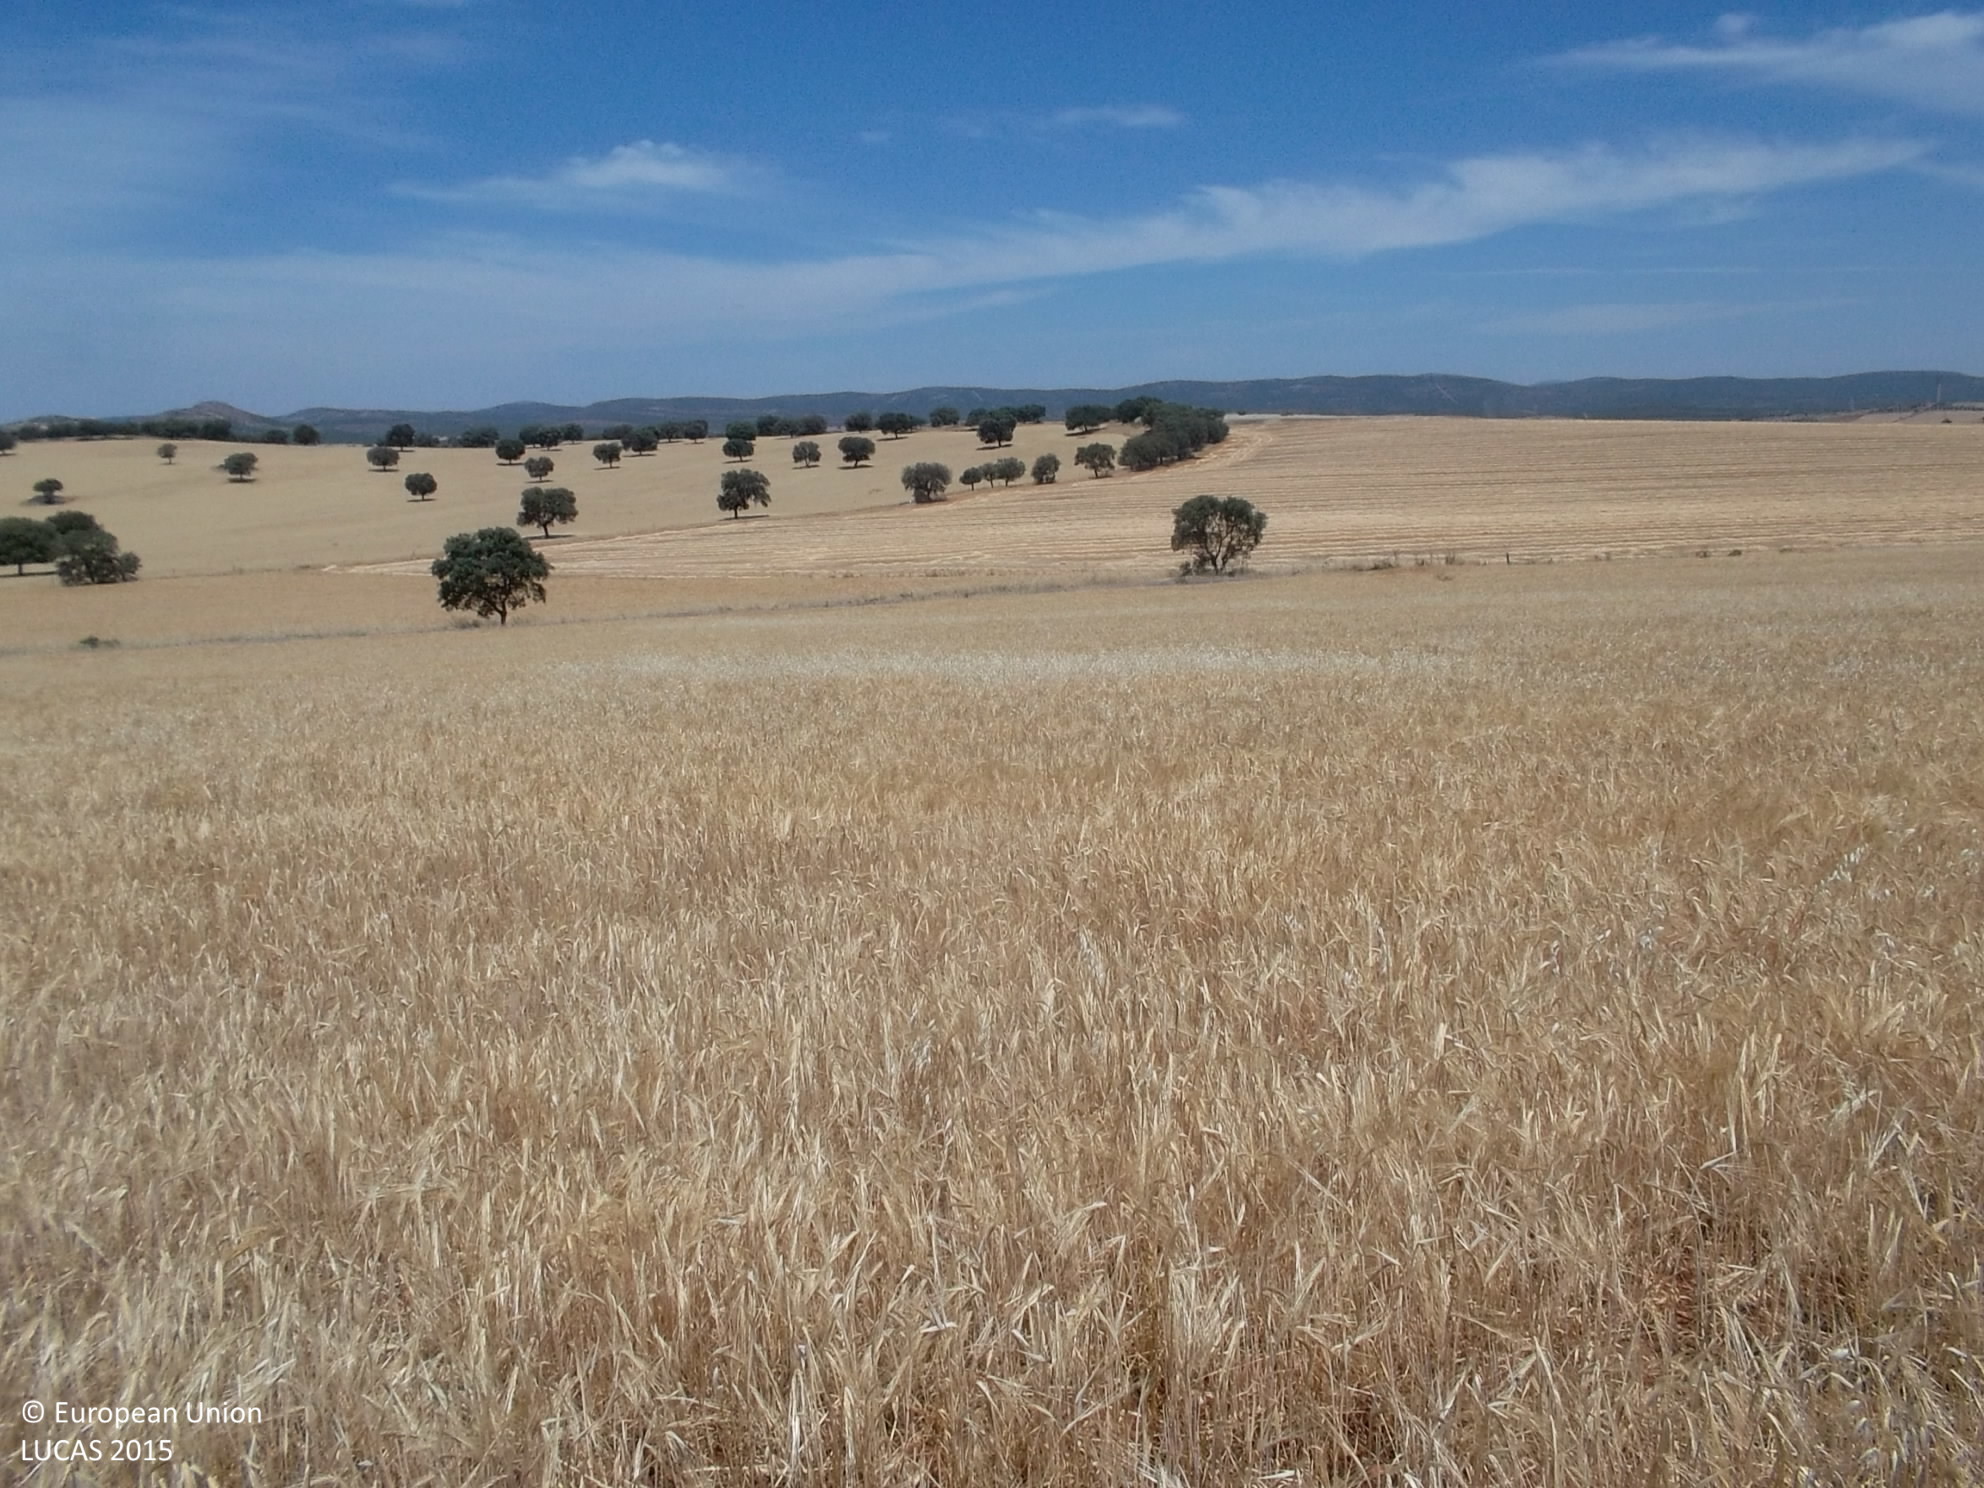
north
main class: Woodland
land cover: Broadleaved woodland
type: broadleaved evergreen forest
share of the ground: 25 - 50 %
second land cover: Spontaneously vegetated surfaces
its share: > 75 %
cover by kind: broadleaved forest trees 40 %, shrubs 30 %, herbaceous plants 30 %
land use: Forestry
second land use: Agriculture (excluding fallow land and kitchen gardens)
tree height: > 5 m
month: June
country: ES
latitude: 39.0183
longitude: -4.0087
